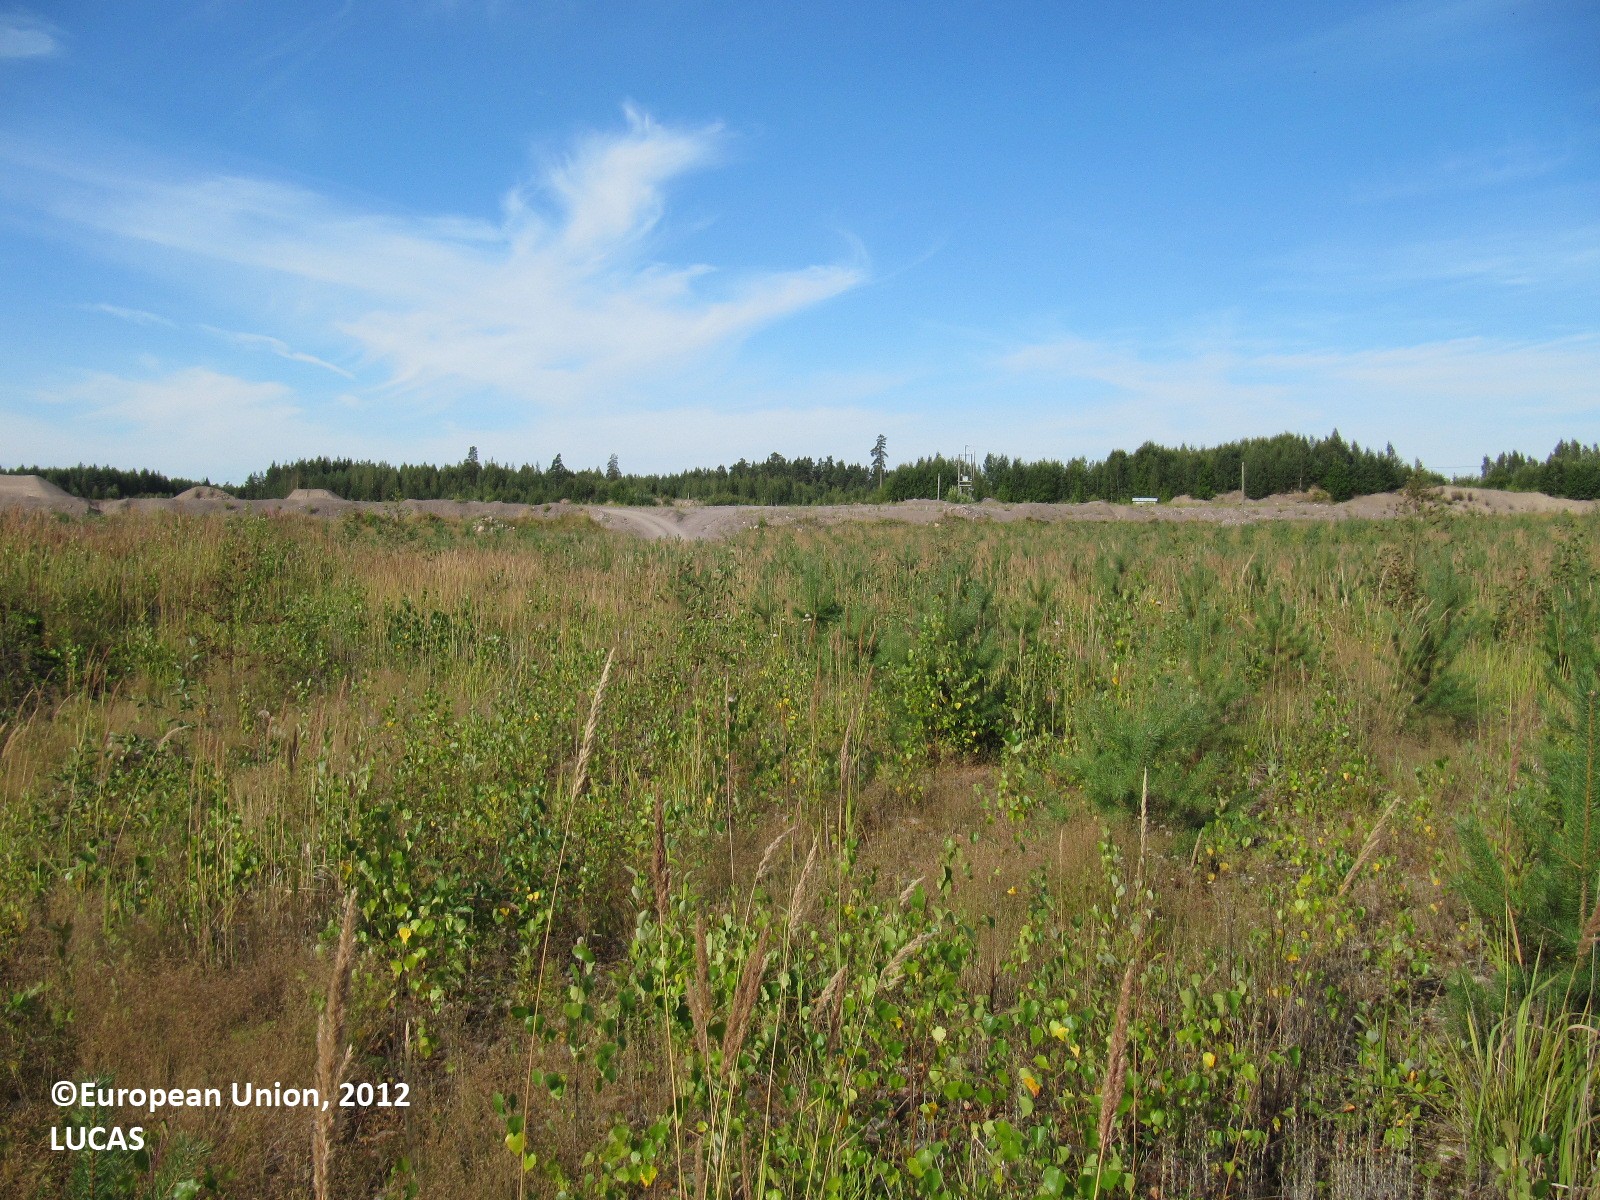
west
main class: Woodland
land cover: Other mixed woodland
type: boreal forest
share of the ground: > 75 %
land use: Mining and quarrying
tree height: < 5 m
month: August
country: FI
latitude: 60.5148
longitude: 24.4392
